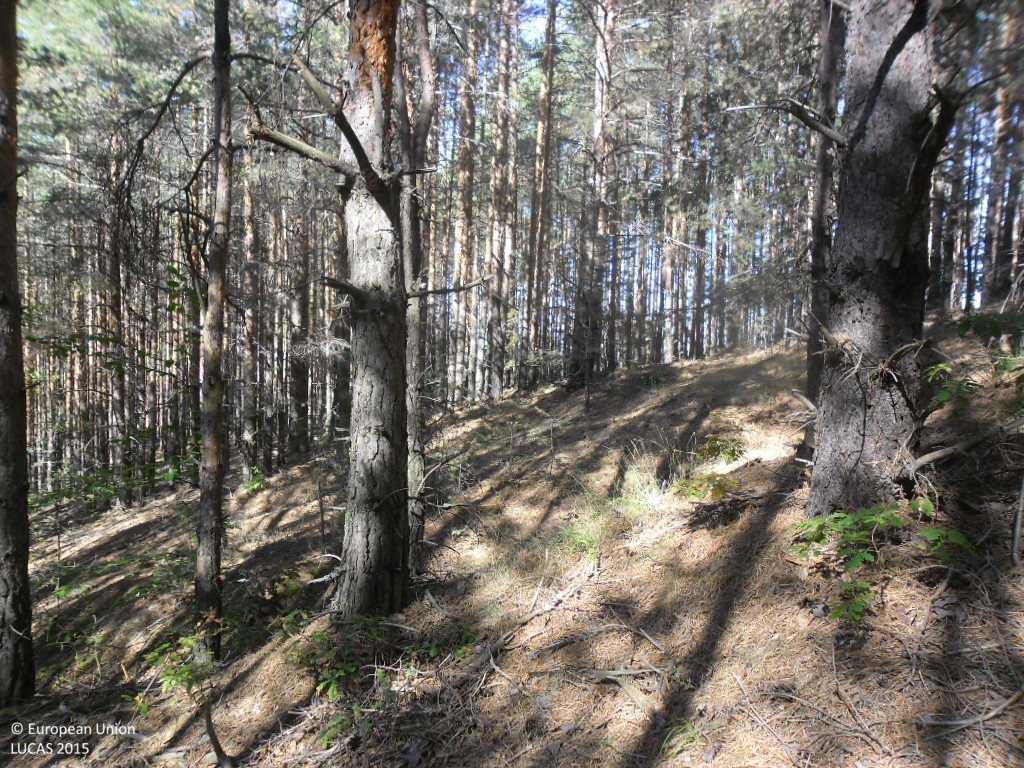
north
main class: Woodland
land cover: Pine dominated coniferous woodland
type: hemiboreal forest and nemoral coniferous forest and mixed broadleaved-coniferous forest
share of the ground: > 75 %
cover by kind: coniferous forest trees 95 %, unconsolidated bare surface 5 %
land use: Forestry
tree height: > 5 m
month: October
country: BG
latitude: 42.1140
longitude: 22.9278
